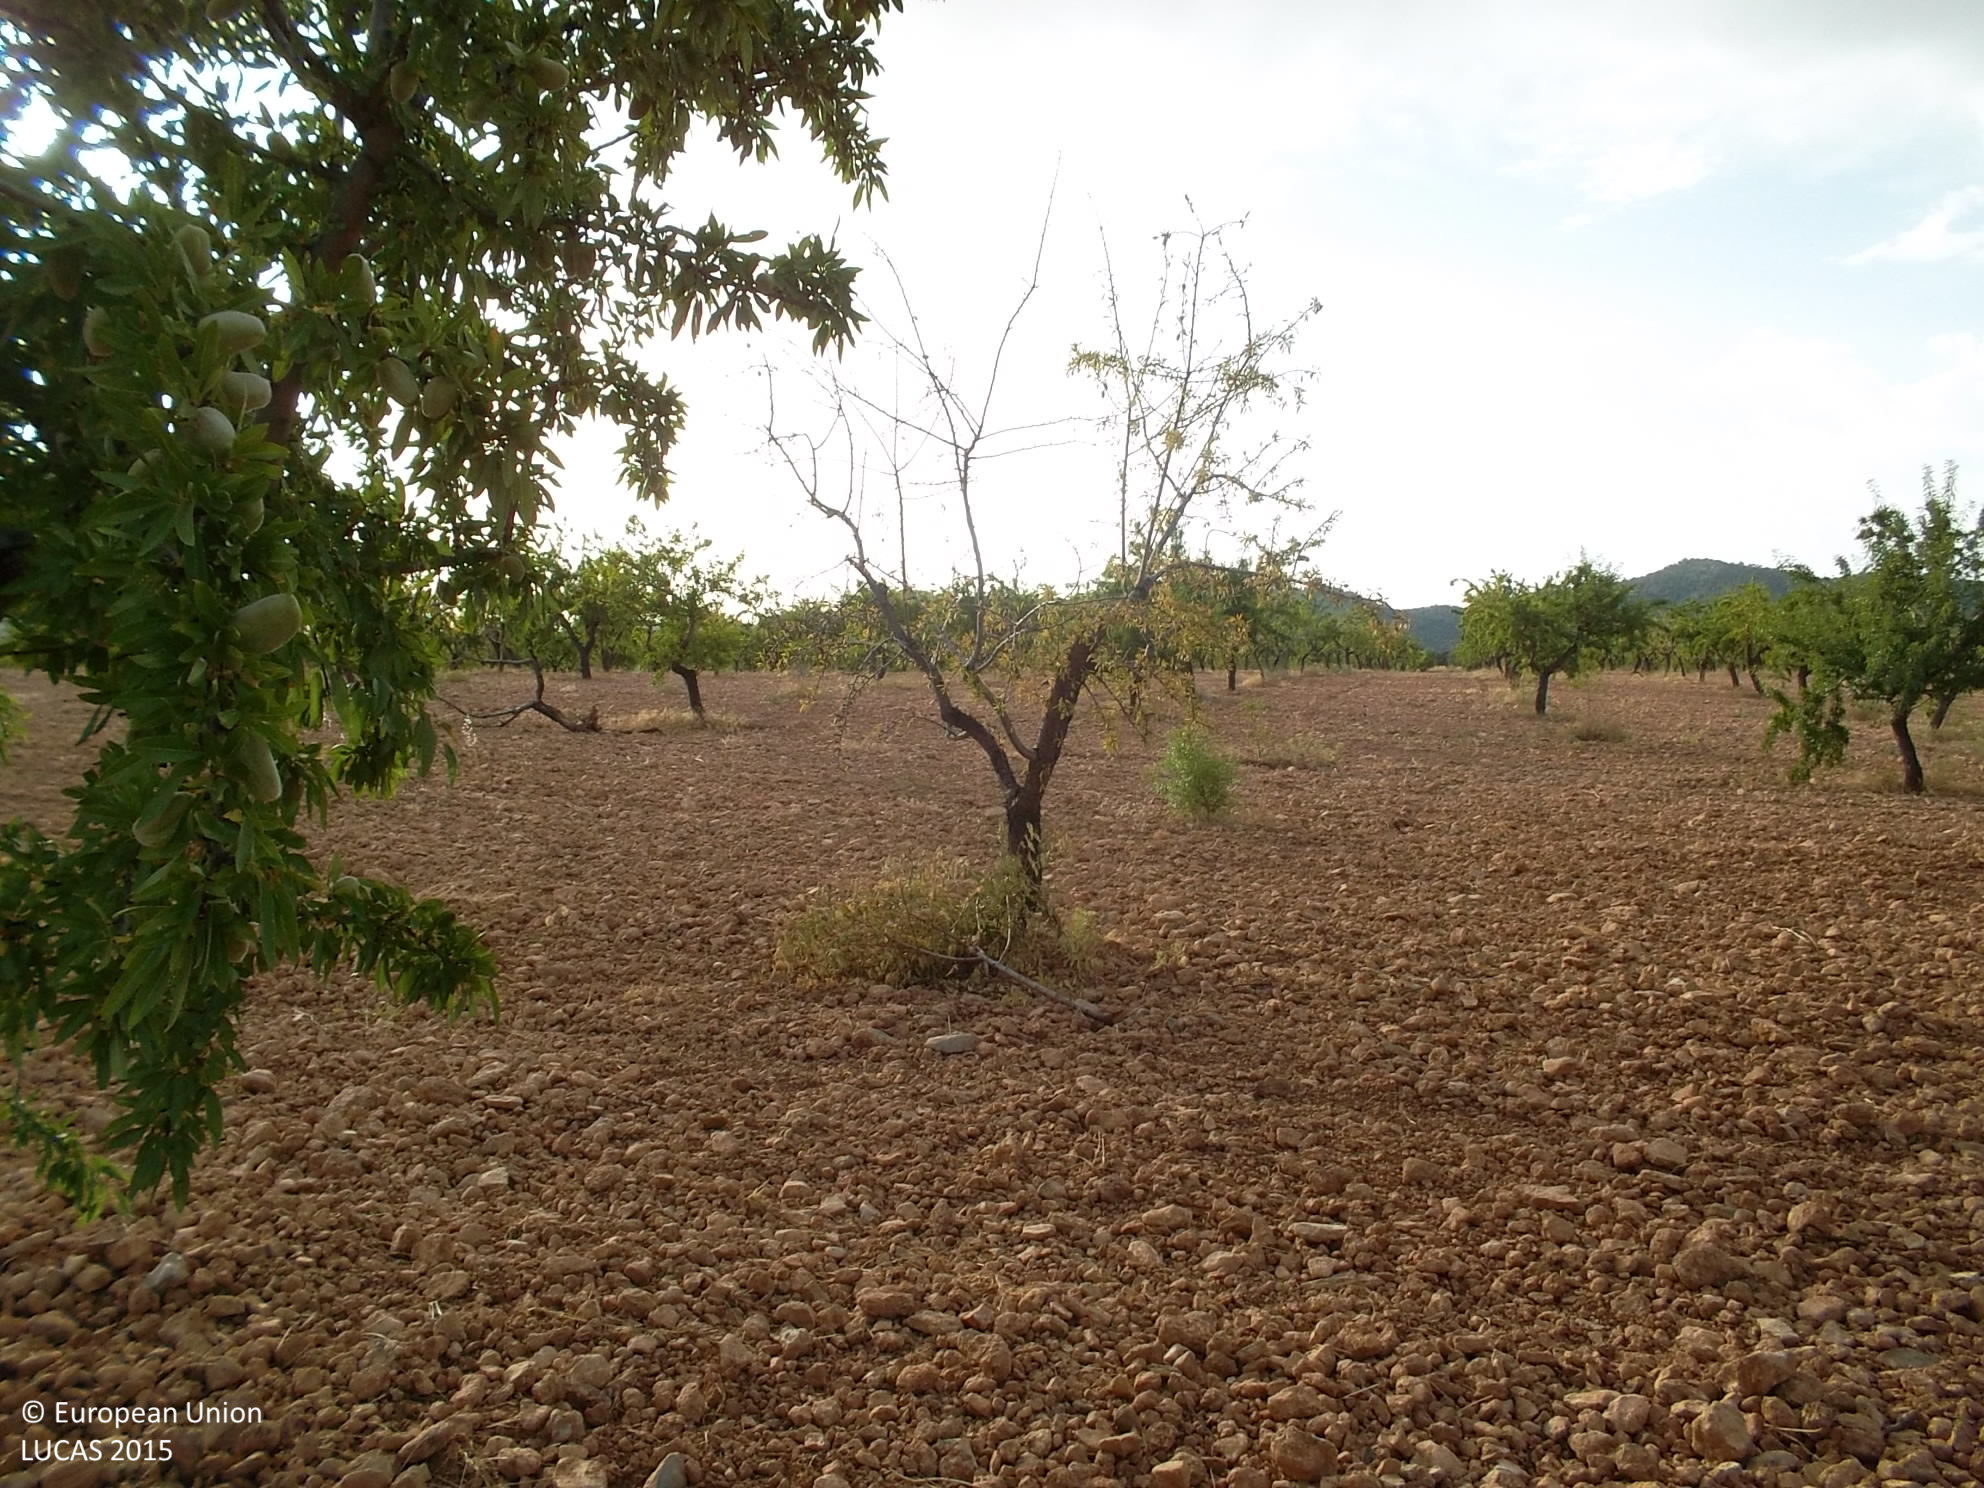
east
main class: Cropland
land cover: Nuts trees
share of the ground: 25 - 50 %
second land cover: Other bare soil
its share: > 75 %
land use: Agriculture (excluding fallow land and kitchen gardens)
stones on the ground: 10 - 25 %
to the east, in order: Nuts trees; Other bare soil
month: July
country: ES
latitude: 37.4537
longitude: -2.8859
